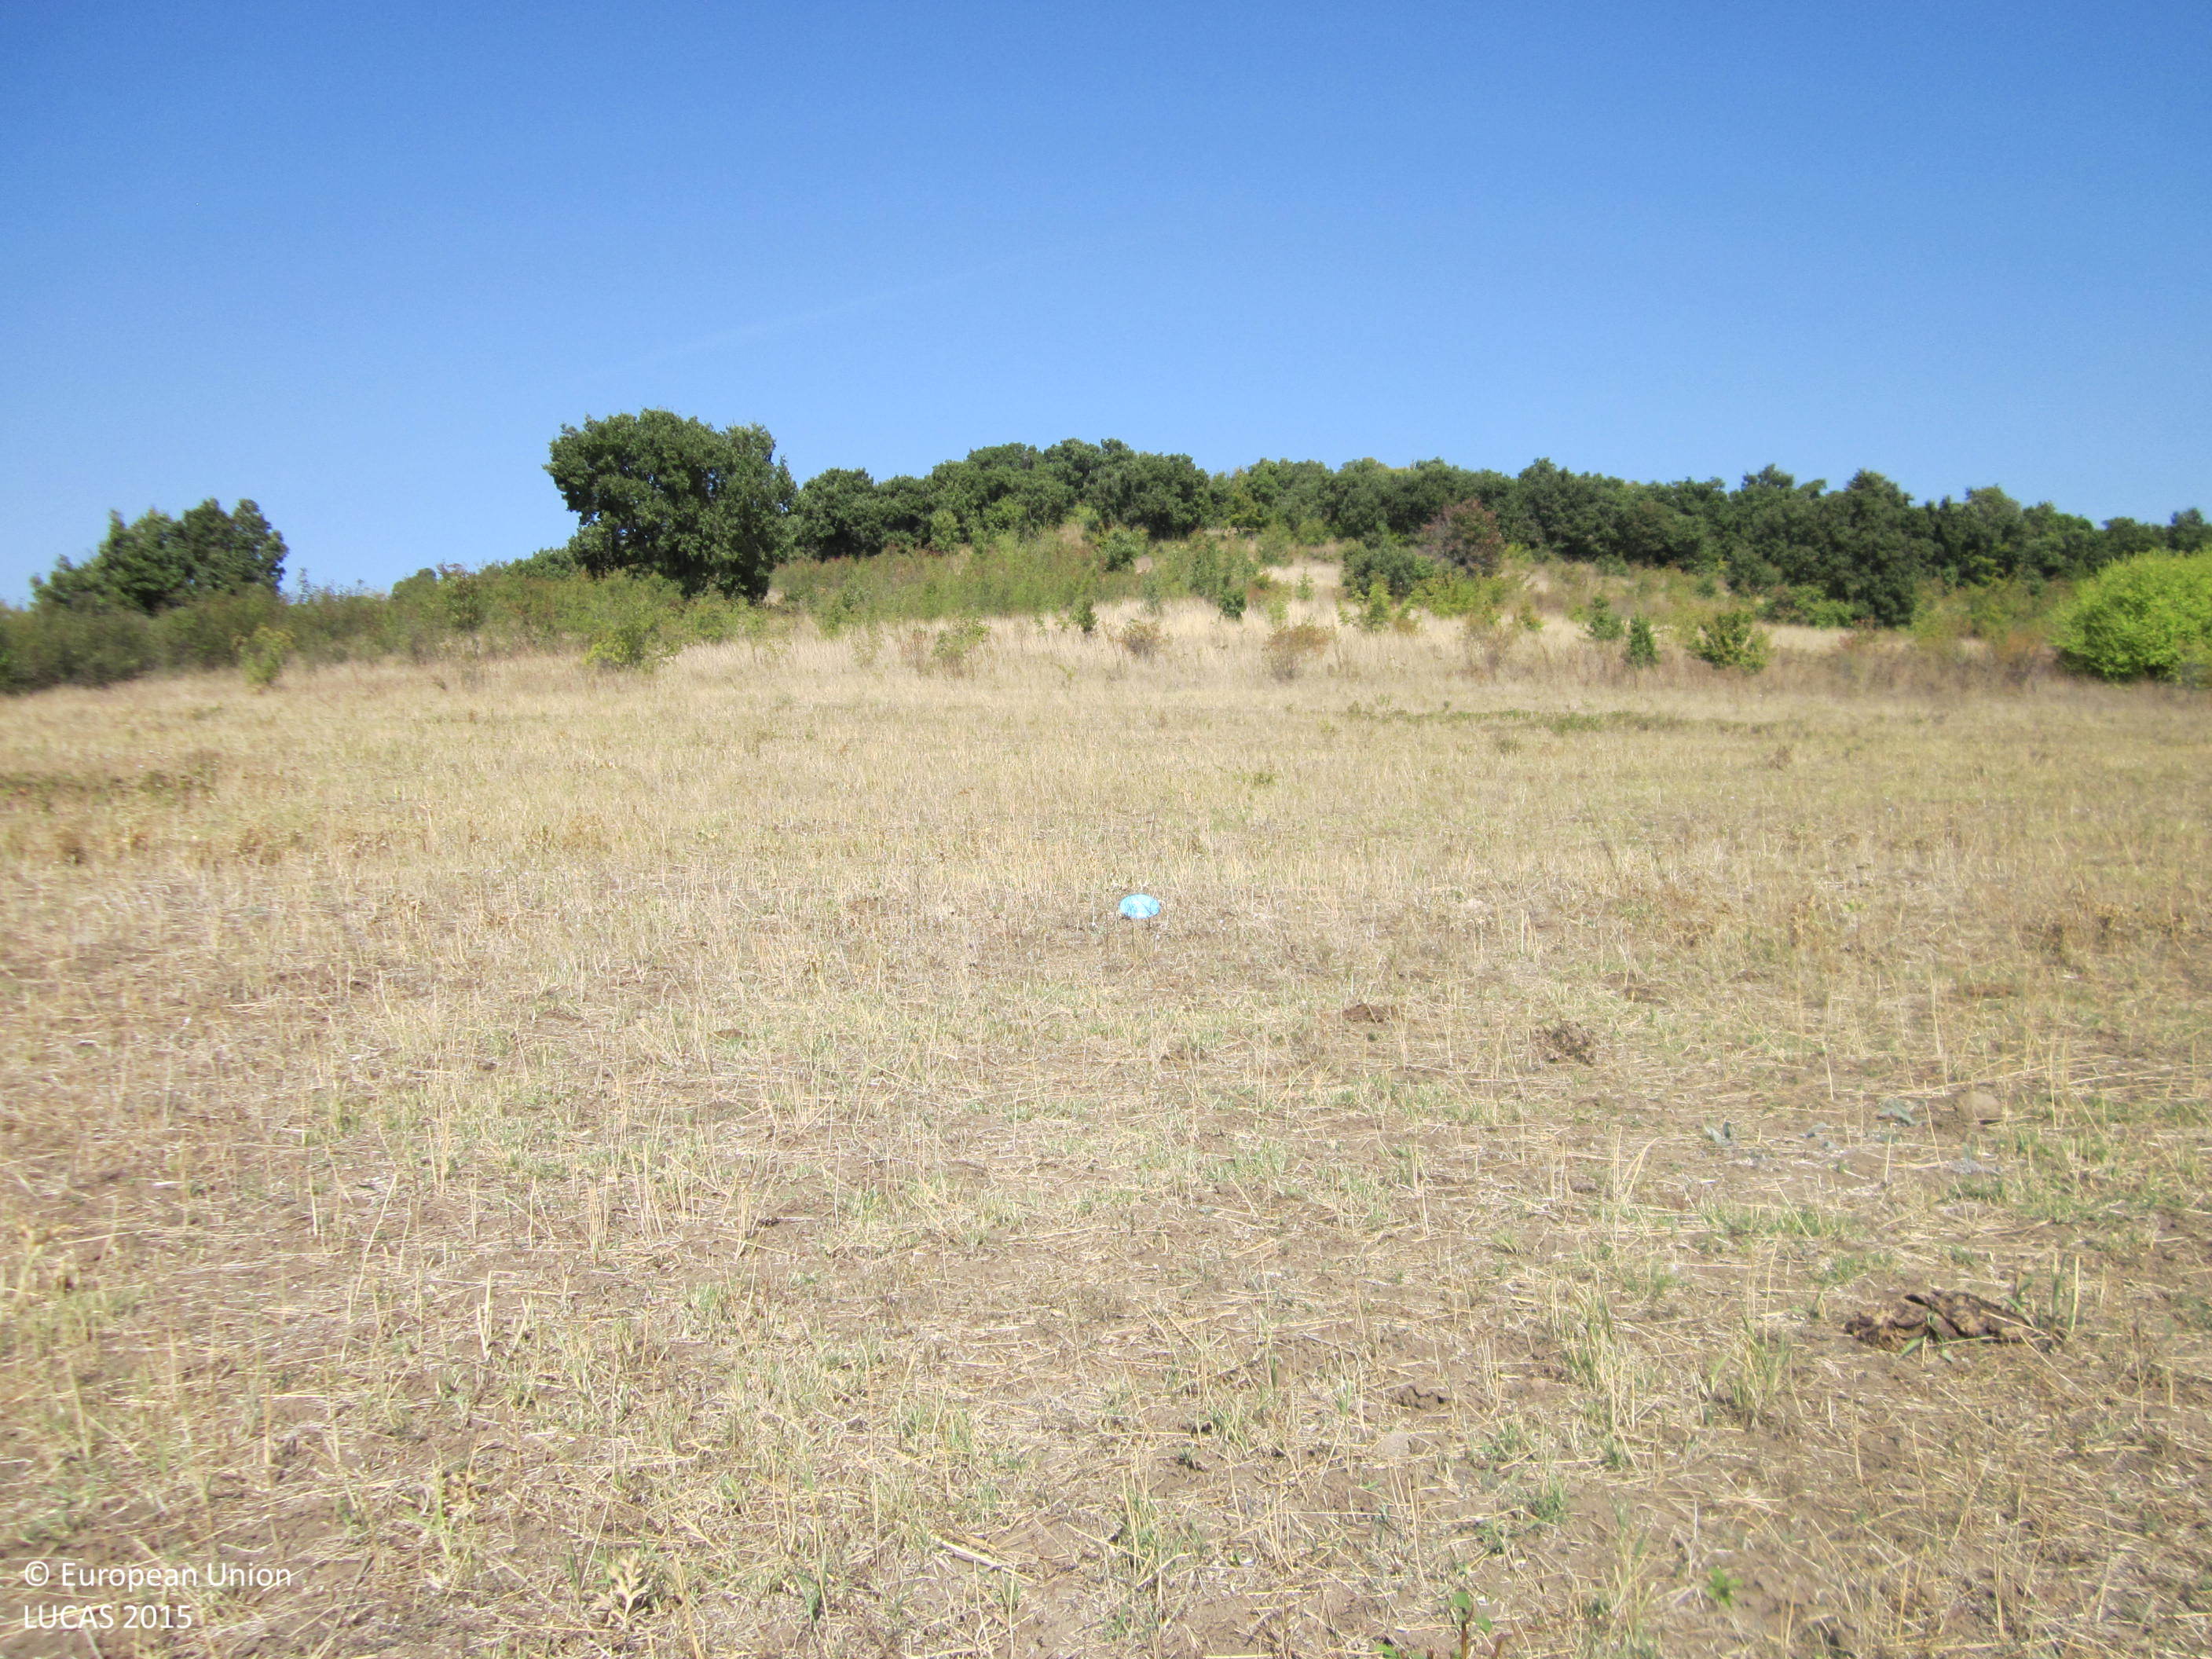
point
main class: Grassland
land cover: Grassland without tree/shrub cover
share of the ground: > 75 %
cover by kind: herbaceous plants 80 %, unconsolidated bare surface 20 %
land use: Agriculture (excluding fallow land and kitchen gardens)
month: September
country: BG
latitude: 42.6372
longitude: 27.4477
